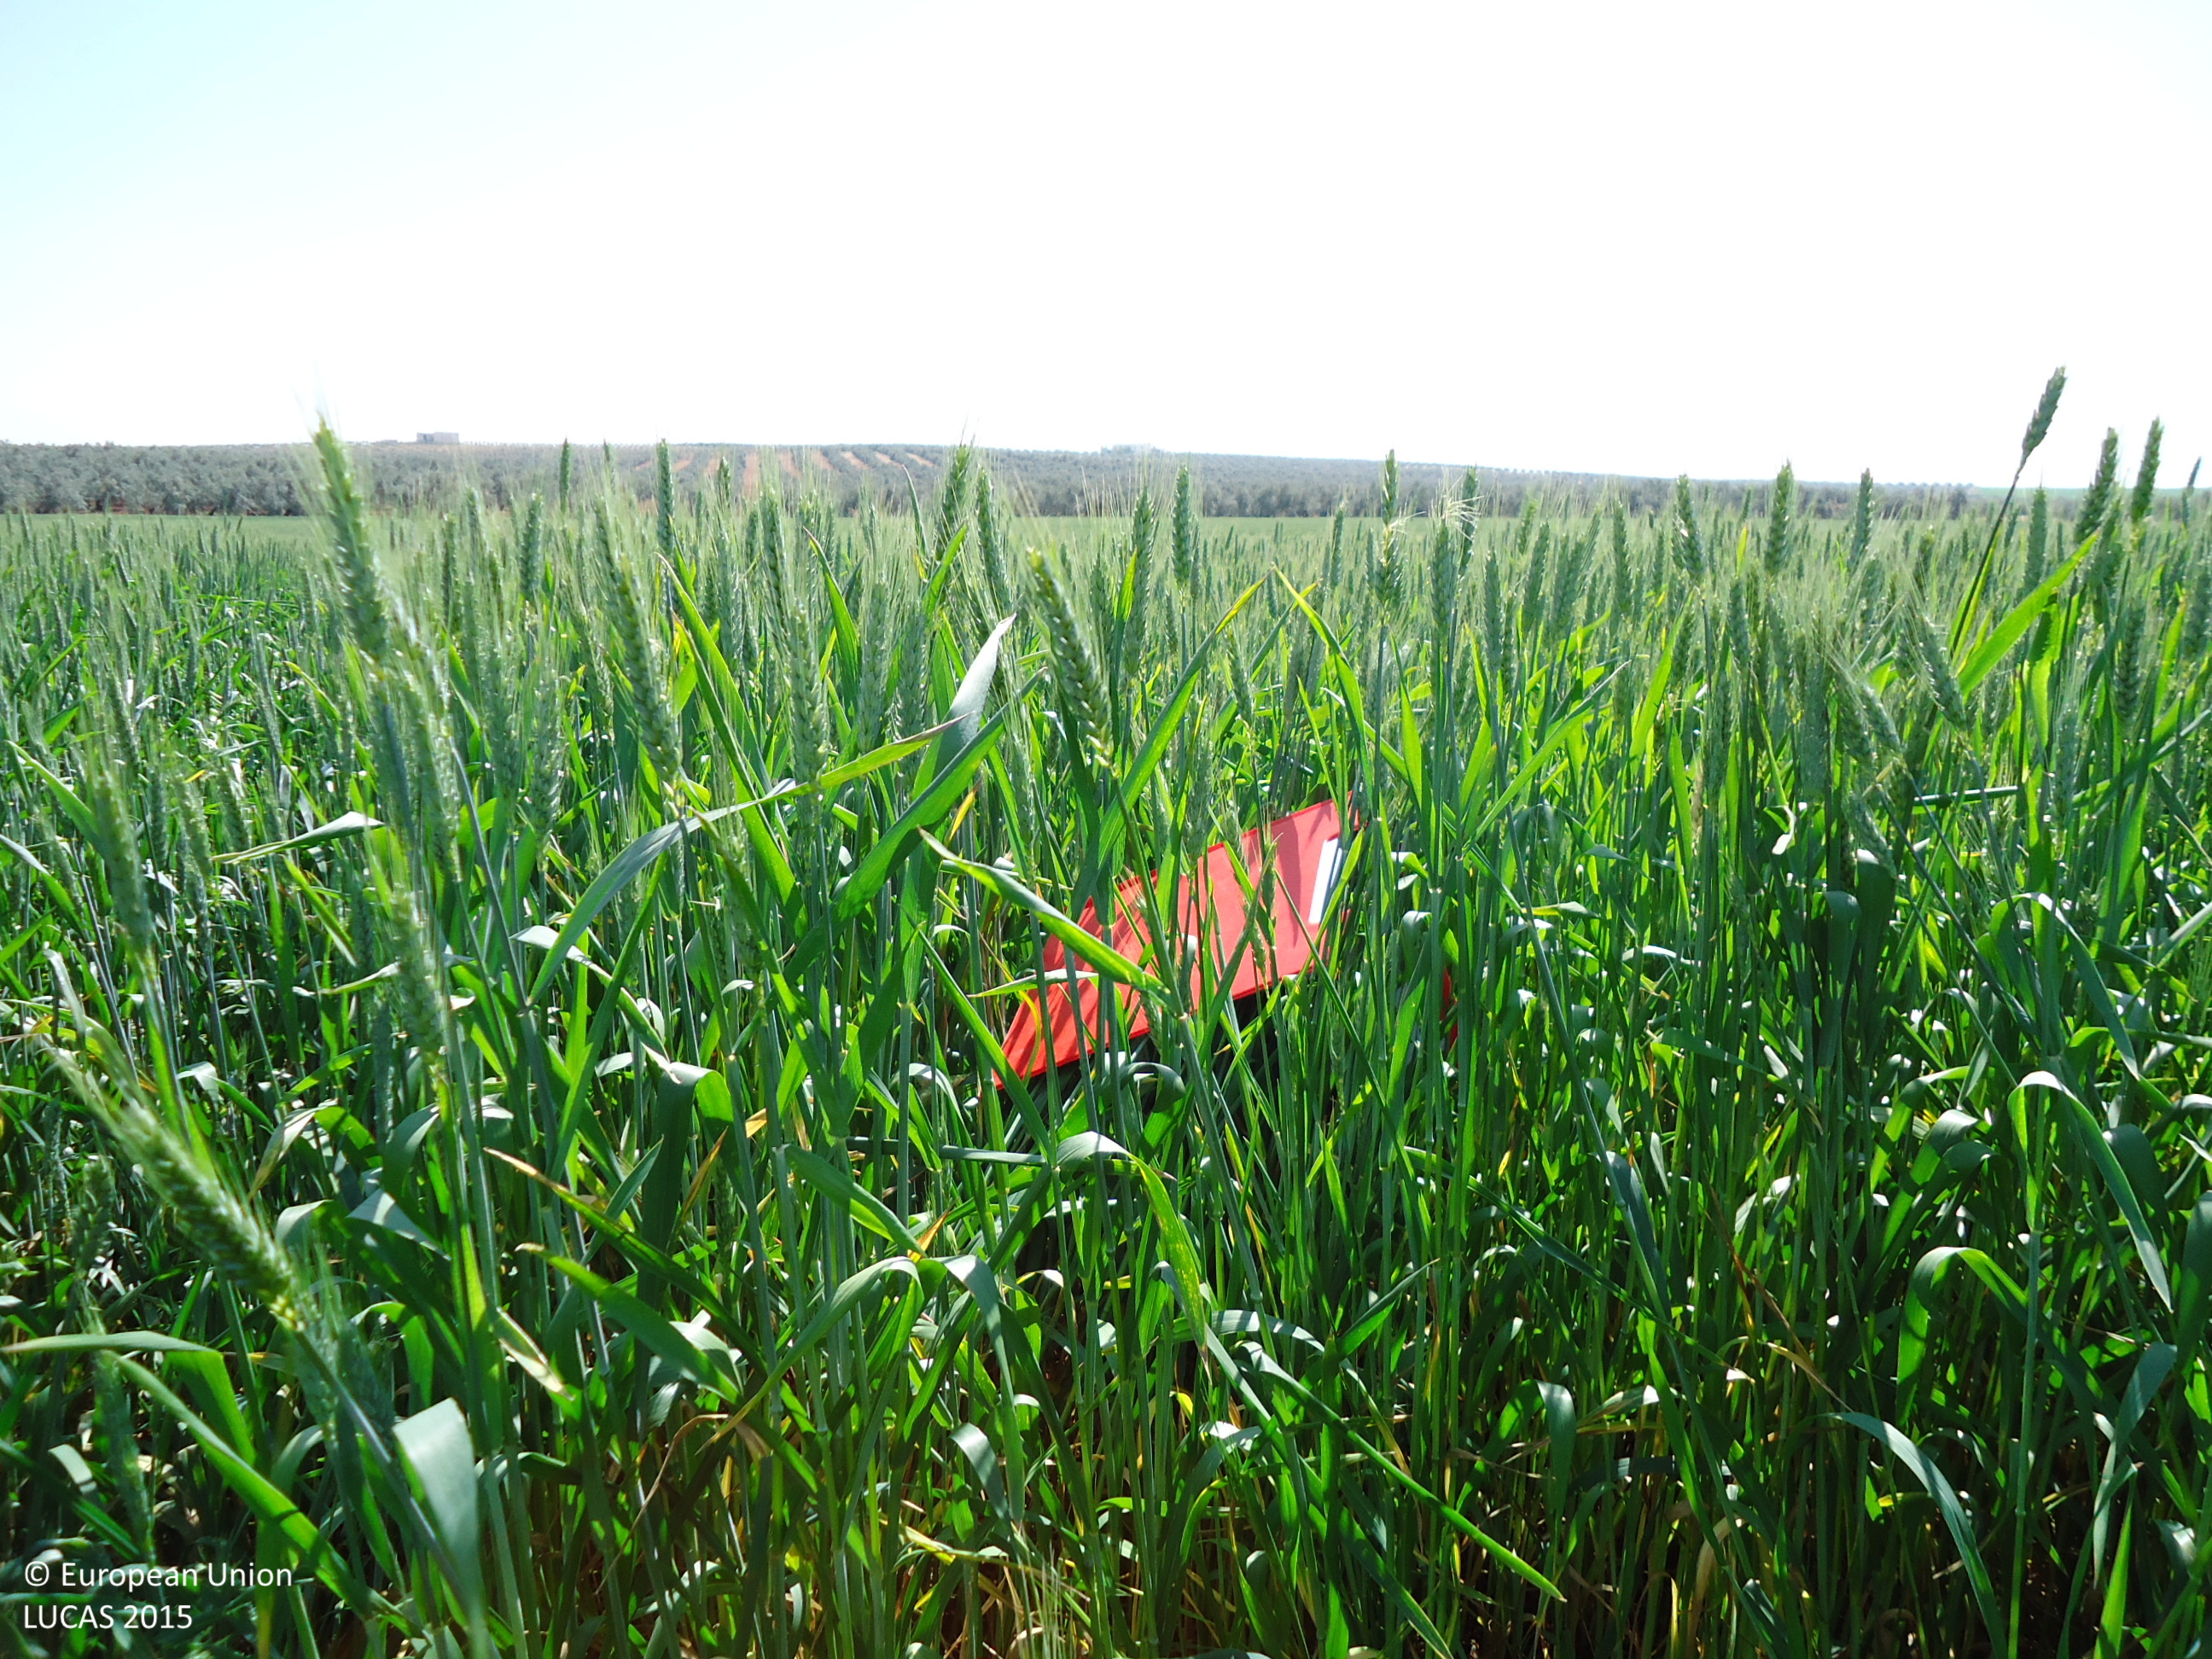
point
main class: Cropland
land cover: Common wheat
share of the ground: > 75 %
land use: Agriculture (excluding fallow land and kitchen gardens)
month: April
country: ES
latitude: 37.0627
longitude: -4.7891
